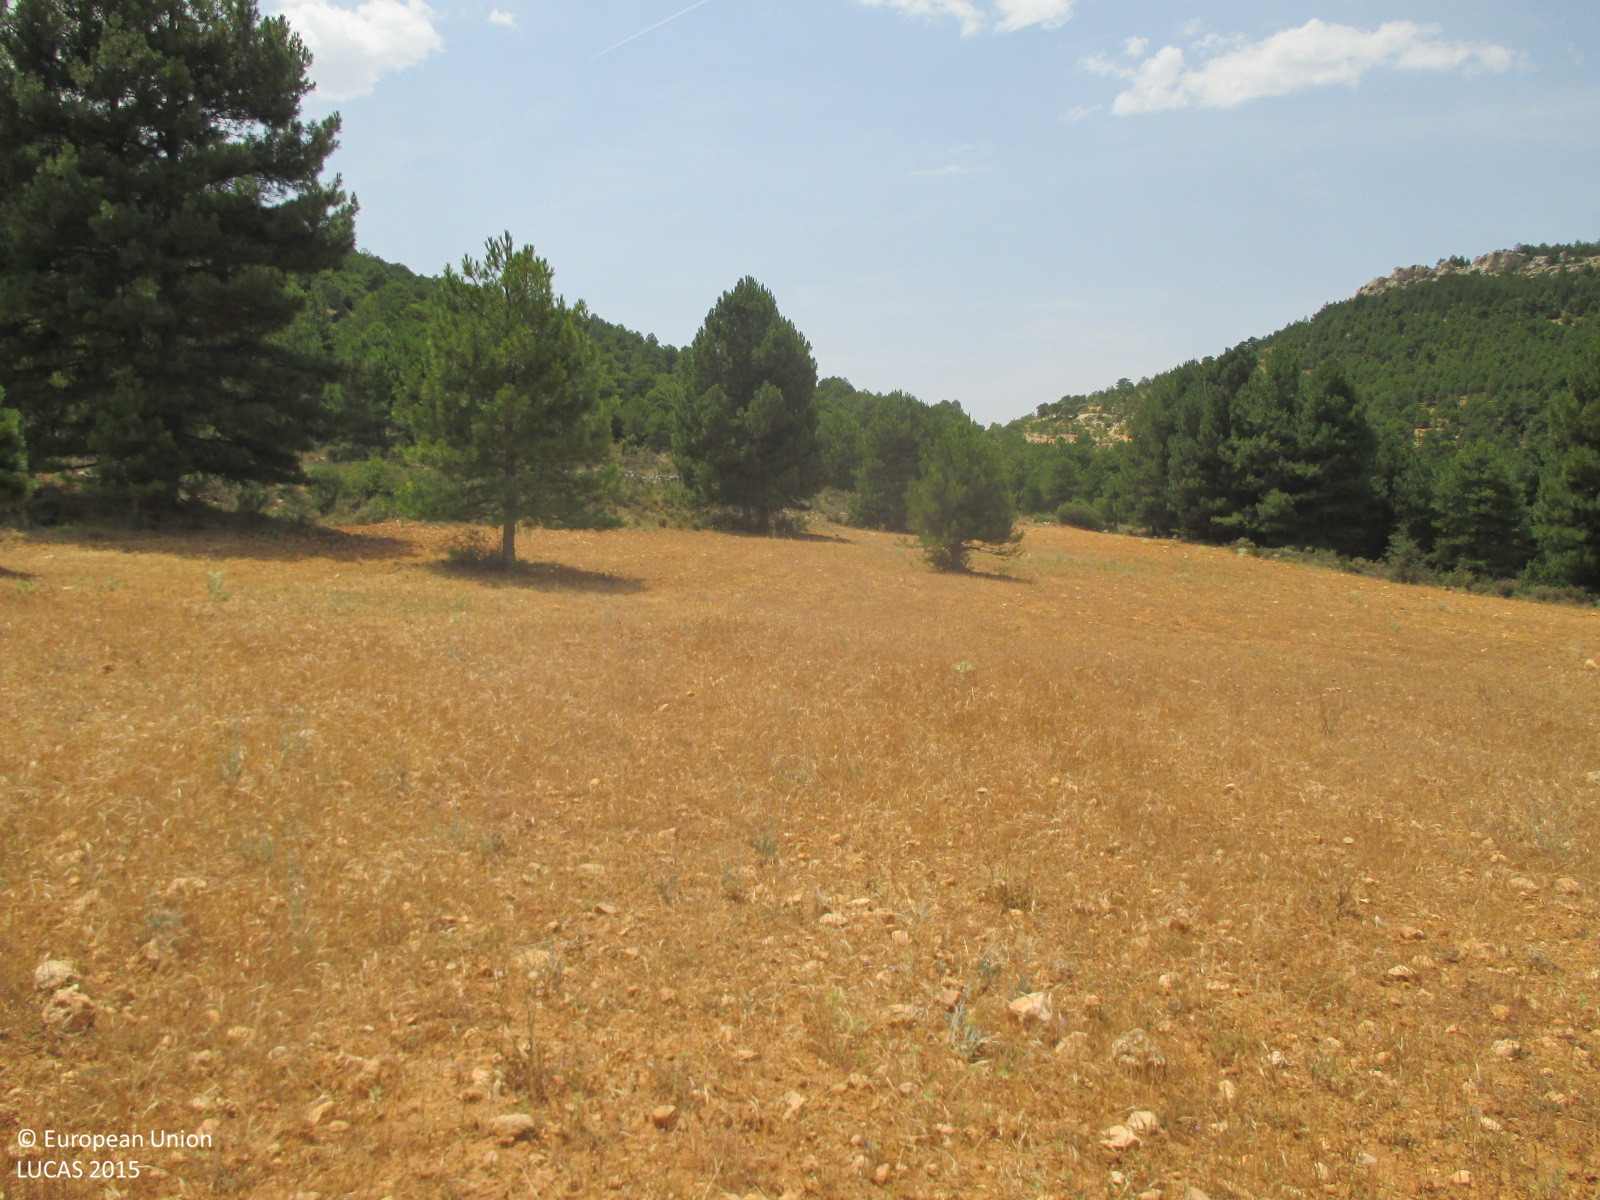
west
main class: Grassland
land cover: Grassland with sparse tree/shrub cover
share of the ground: > 75 %
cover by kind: herbaceous plants 90 %, coniferous forest trees 5 %, unconsolidated bare surface 5 %
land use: Agriculture (excluding fallow land and kitchen gardens)
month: July
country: ES
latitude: 38.1688
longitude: -2.3321
